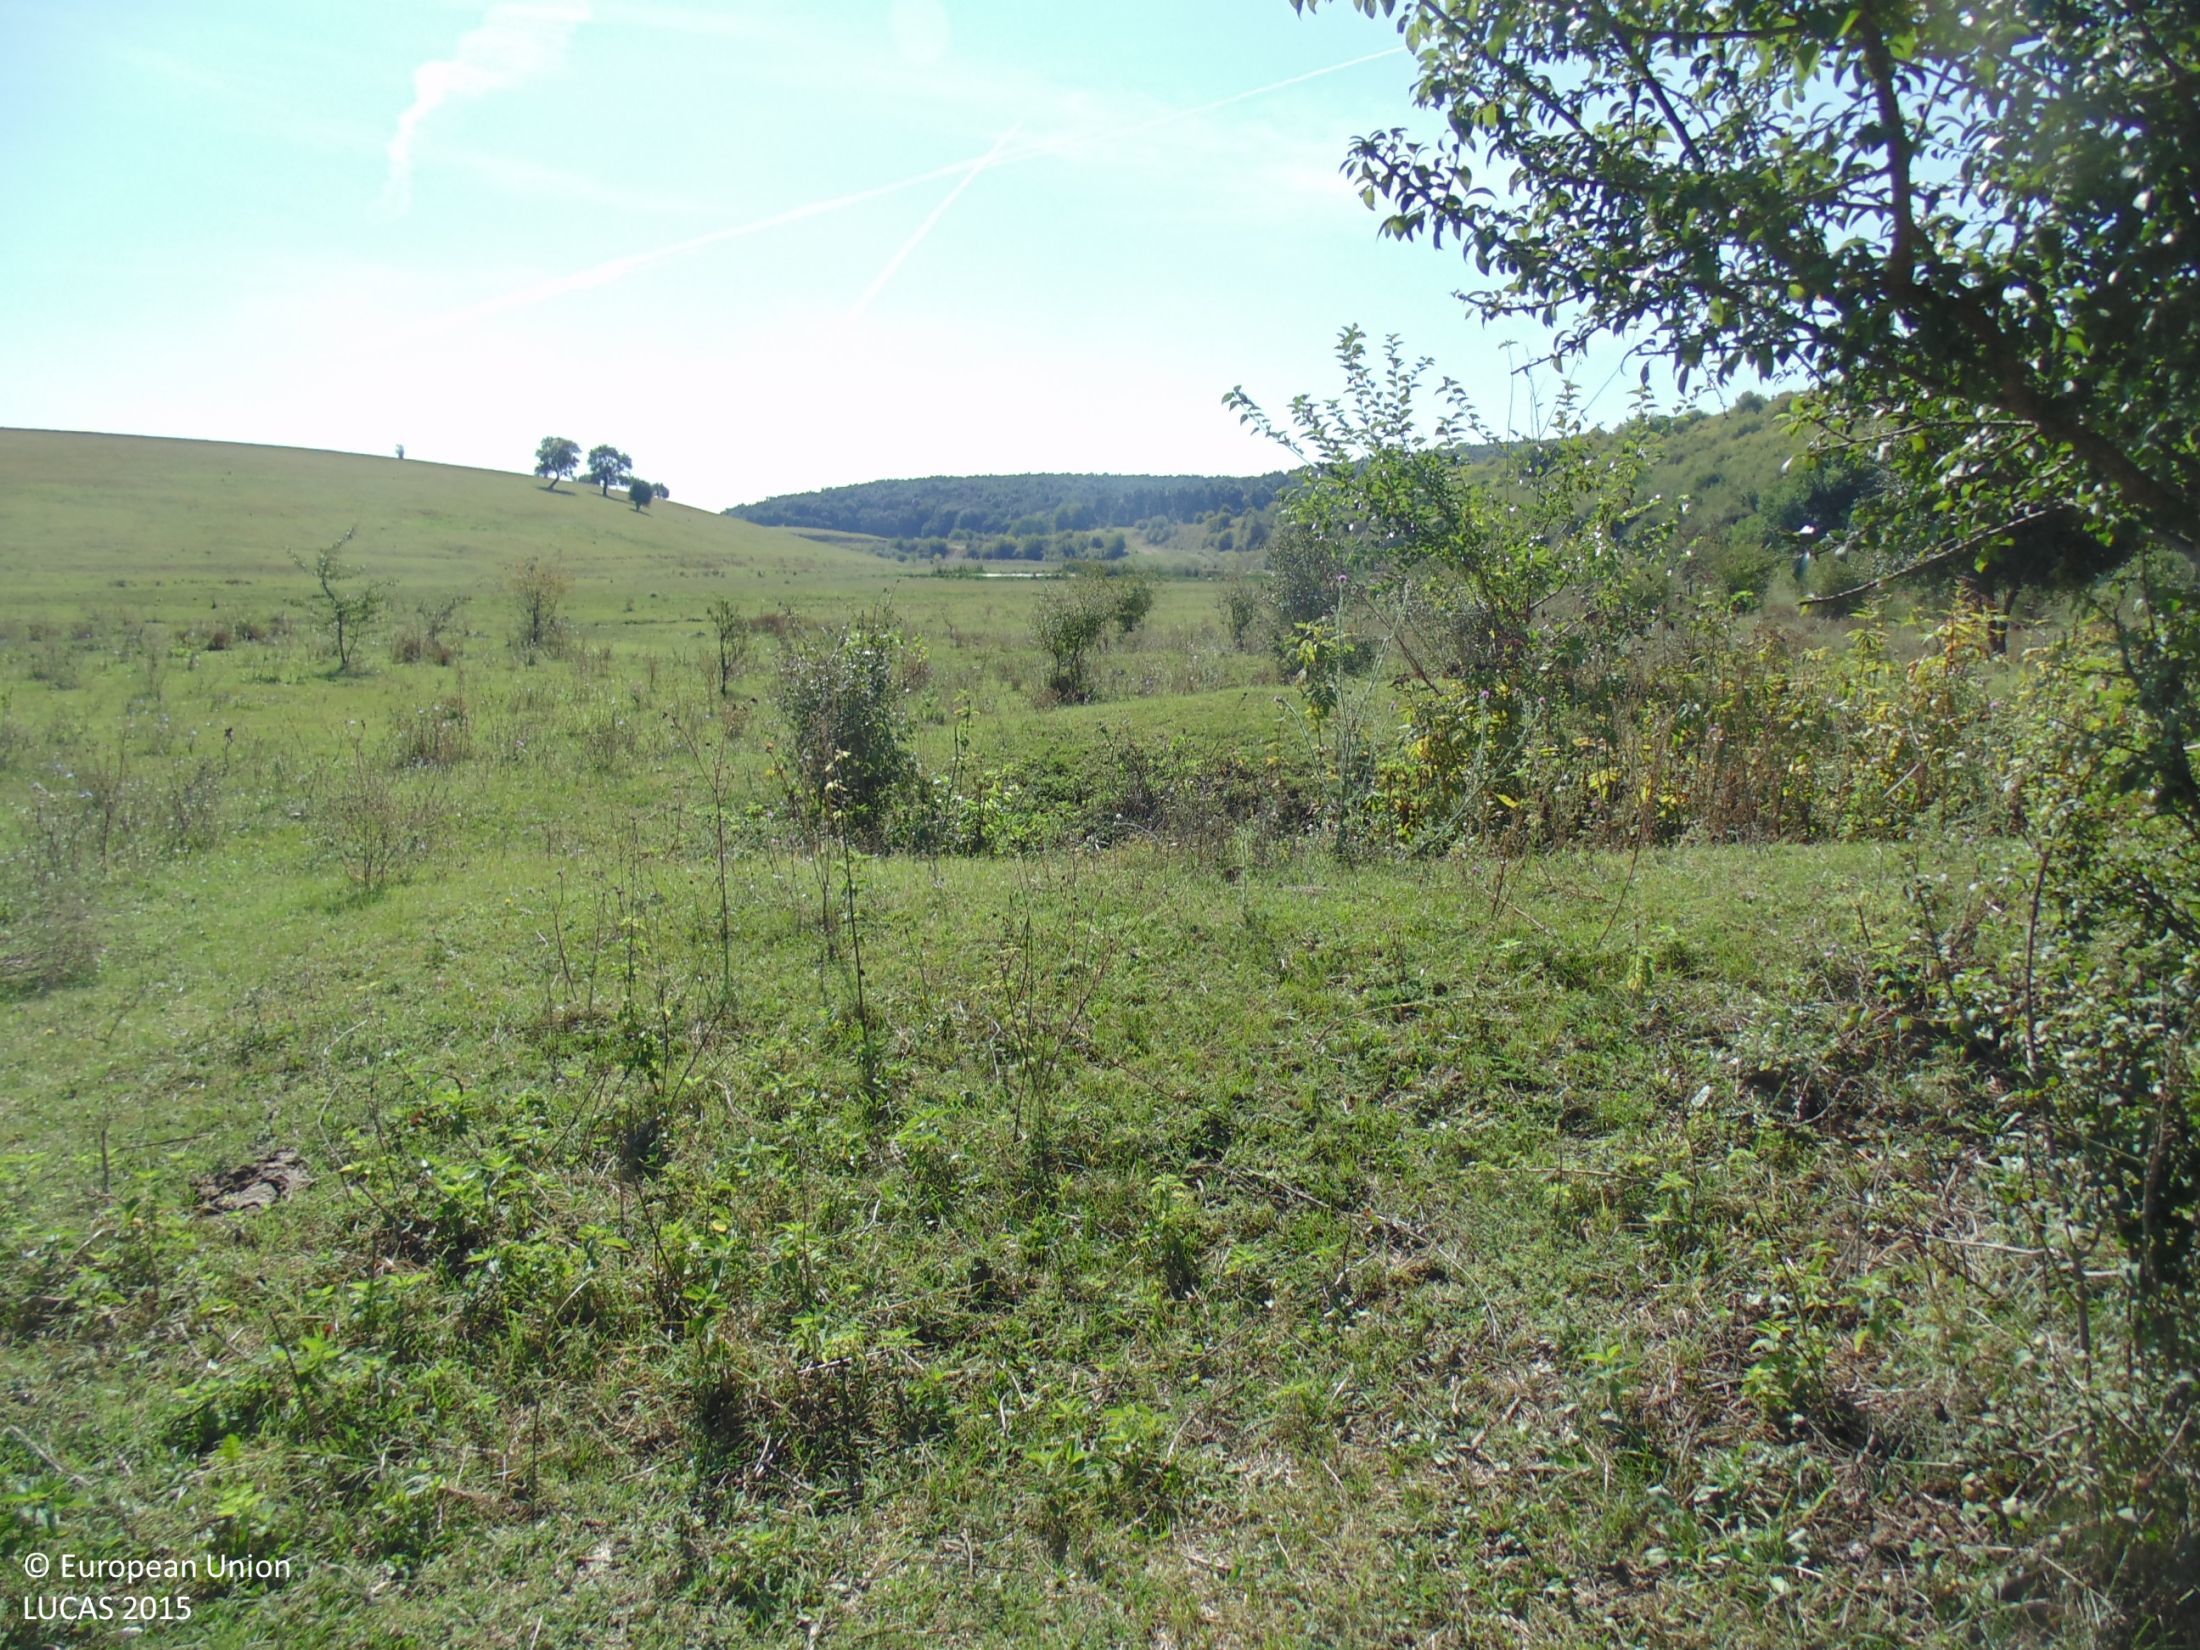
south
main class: Grassland
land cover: Grassland with sparse tree/shrub cover
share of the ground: > 75 %
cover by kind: herbaceous plants 90 %, broadleaved forest trees 5 %, shrubs 5 %
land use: Agriculture (excluding fallow land and kitchen gardens)
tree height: < 5 m
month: September
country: BG
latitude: 44.0514
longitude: 27.0375
